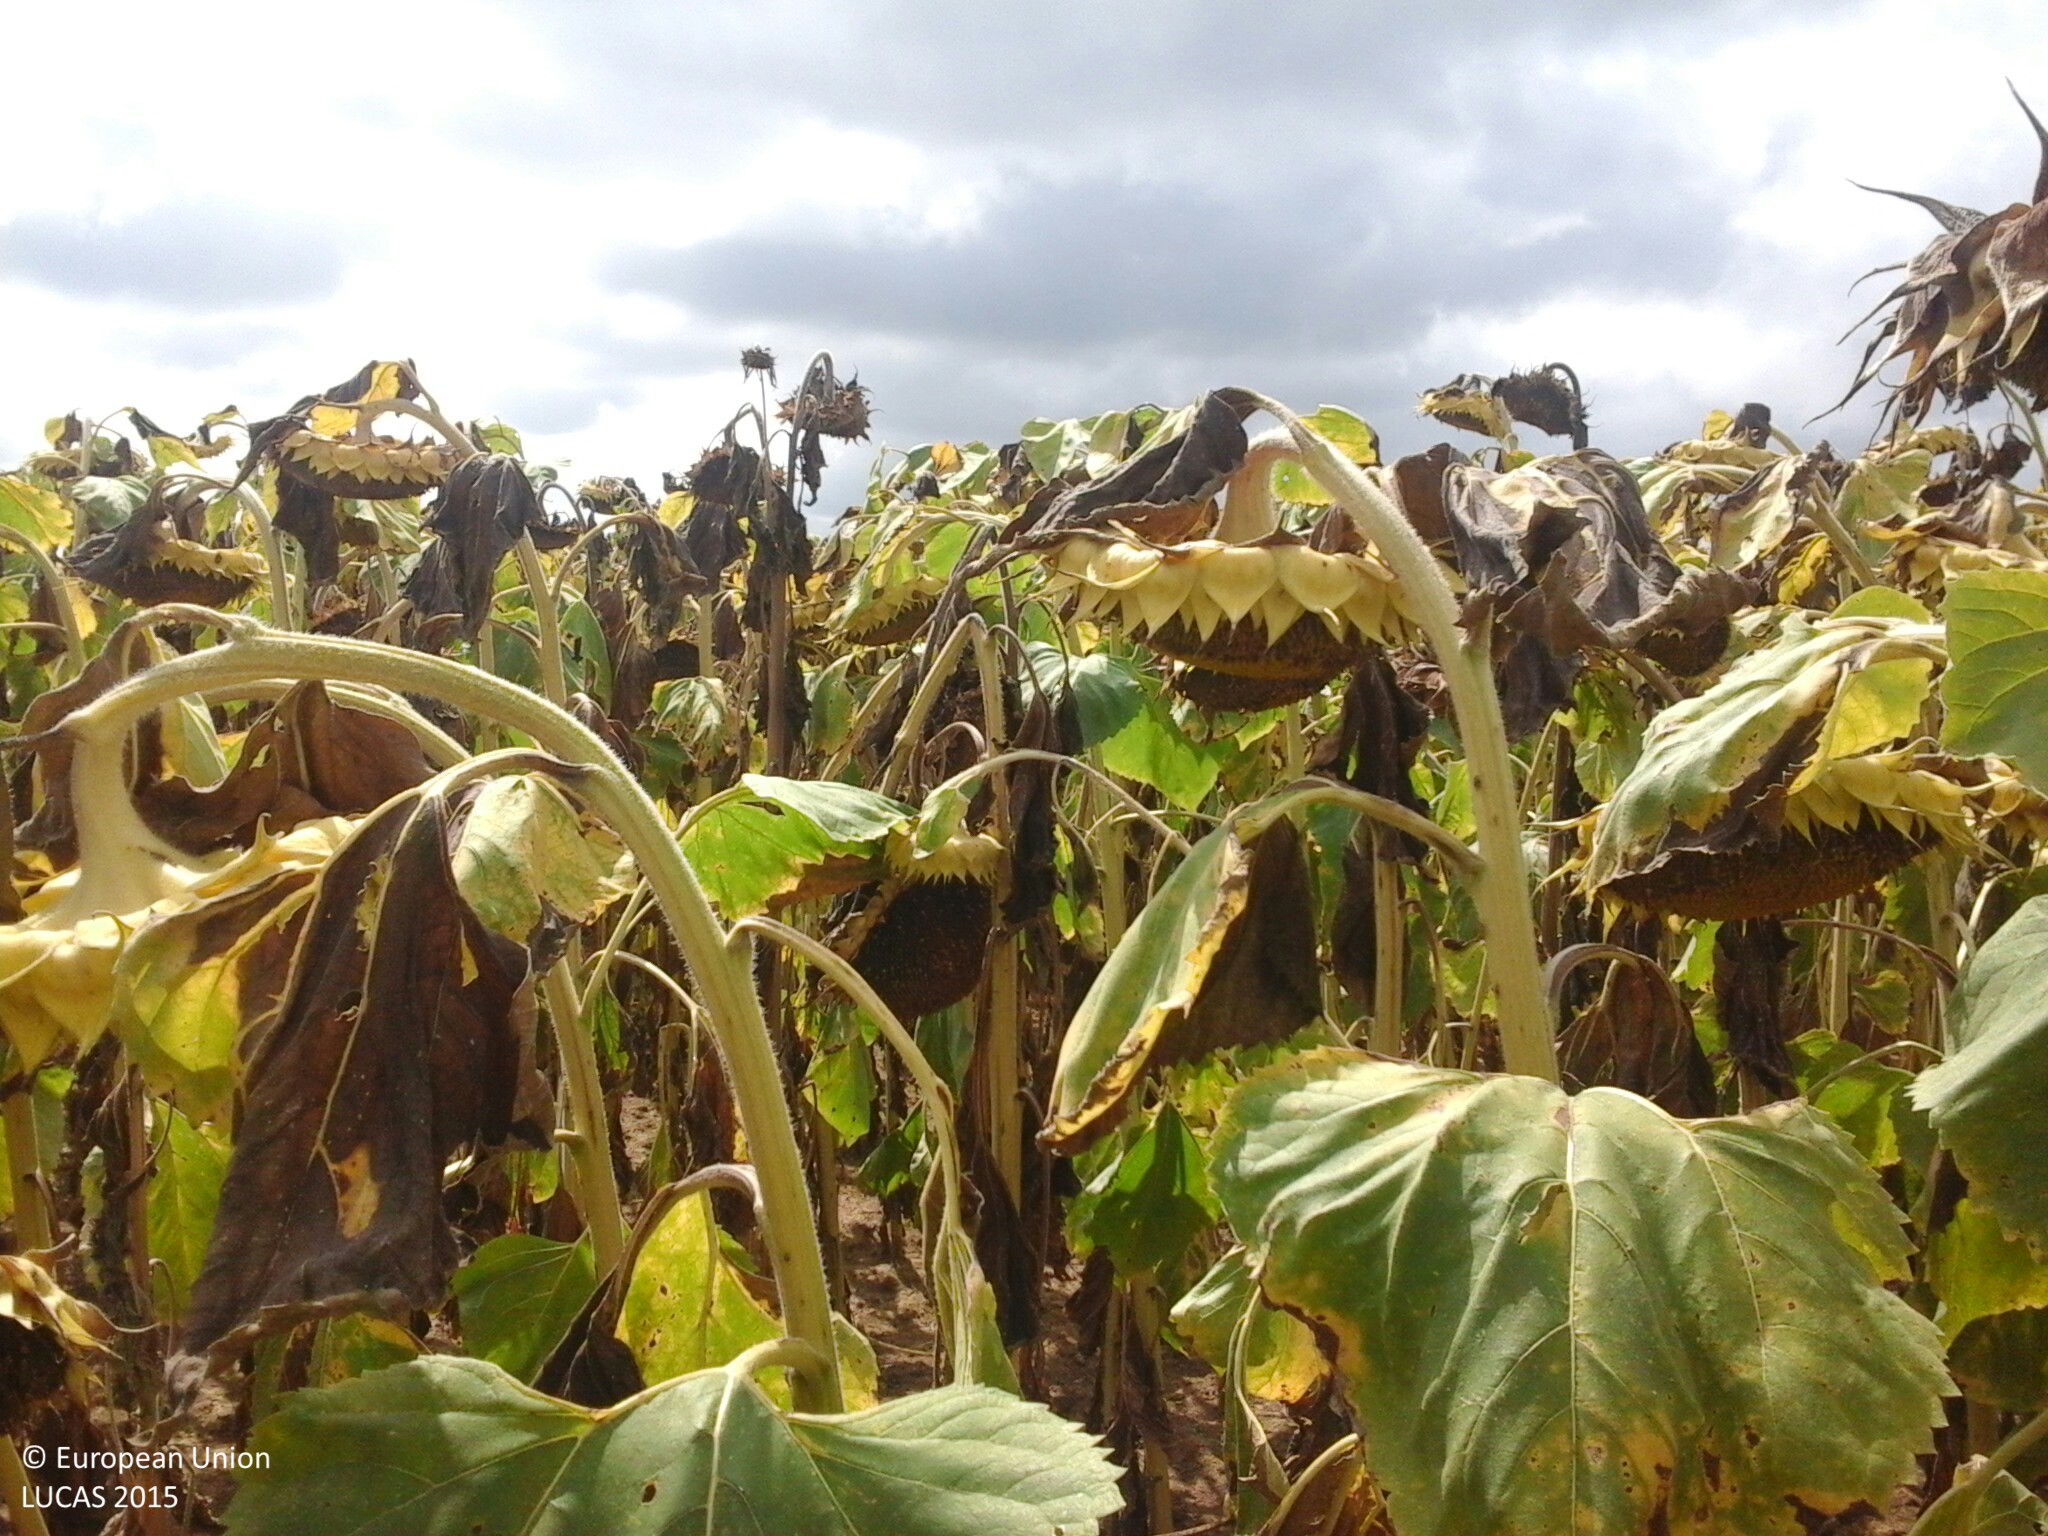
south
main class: Cropland
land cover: Sunflower
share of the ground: > 75 %
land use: Agriculture (excluding fallow land and kitchen gardens)
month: August
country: HU
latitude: 46.9964
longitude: 21.5474
